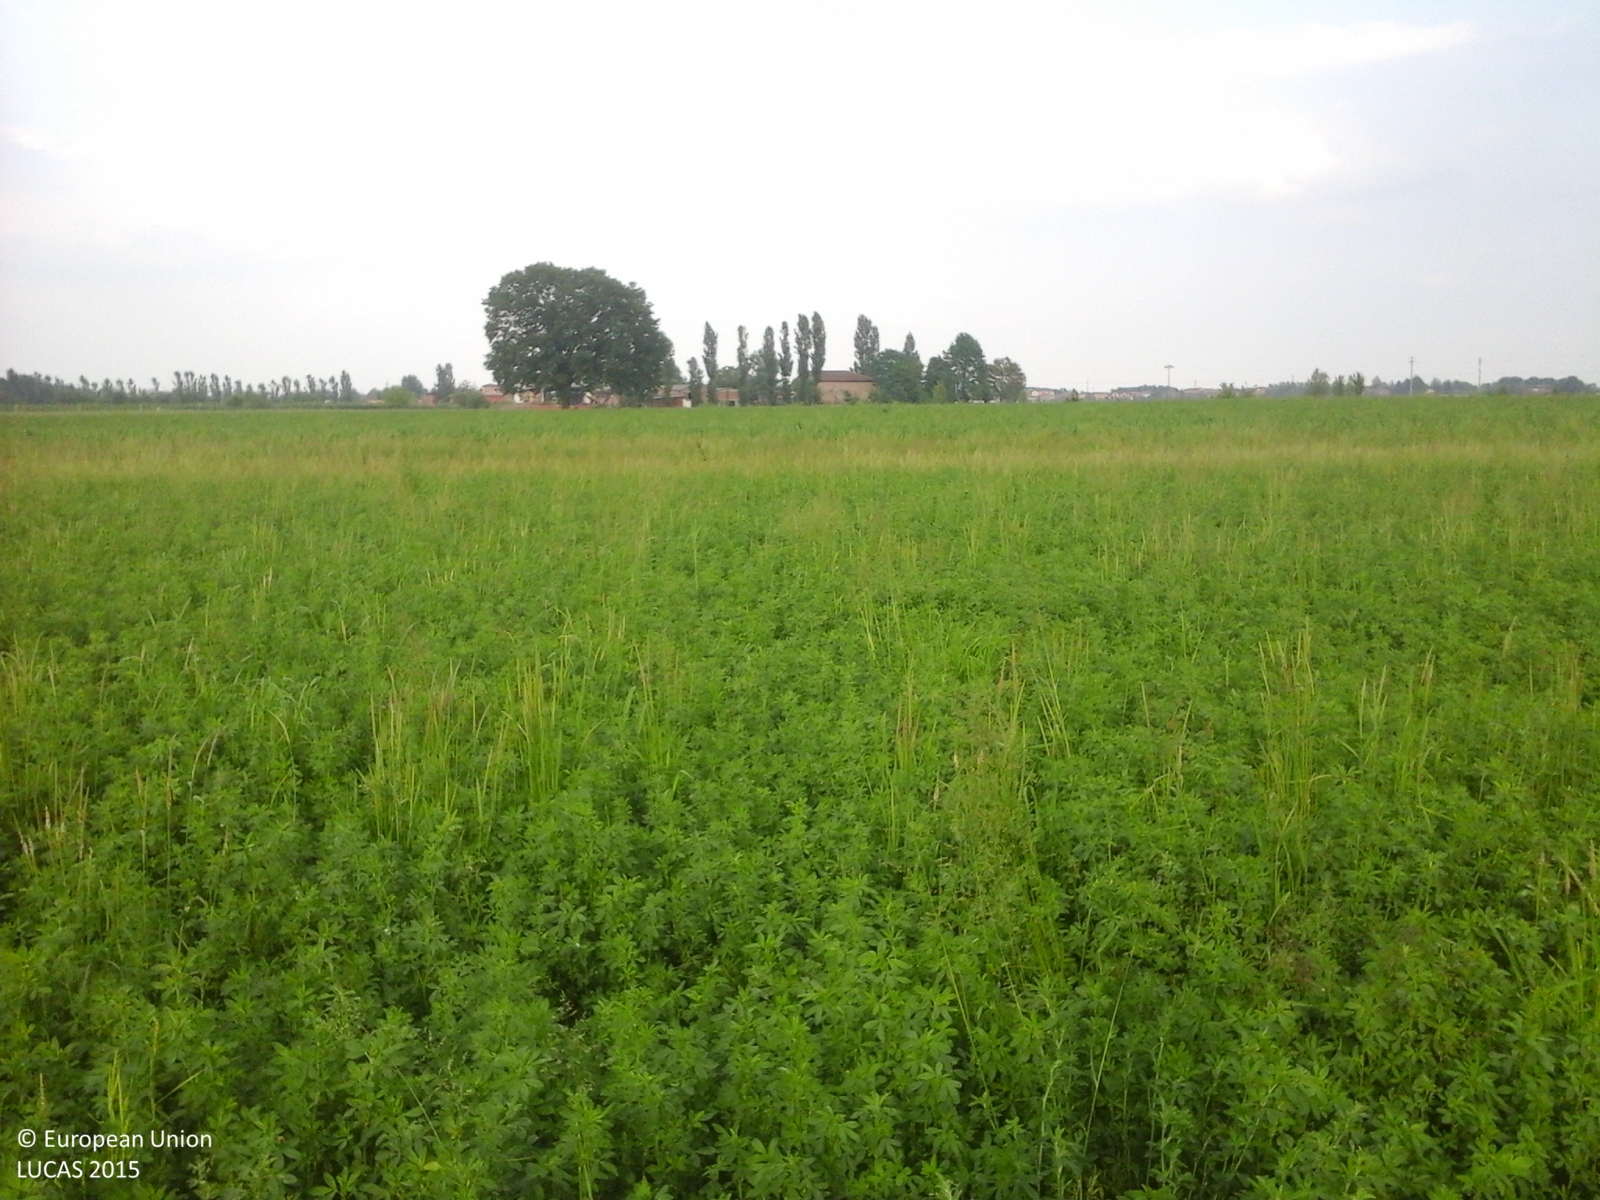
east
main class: Cropland
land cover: Lucerne
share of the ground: > 75 %
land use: Agriculture (excluding fallow land and kitchen gardens)
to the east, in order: Lucerne; Tracks; Lucerne; Tracks; Sugar beet; Ditches and canals; Sugar beet; Grassland with sparse tree/shrub cover
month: April
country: IT
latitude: 44.6894
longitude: 10.8940
